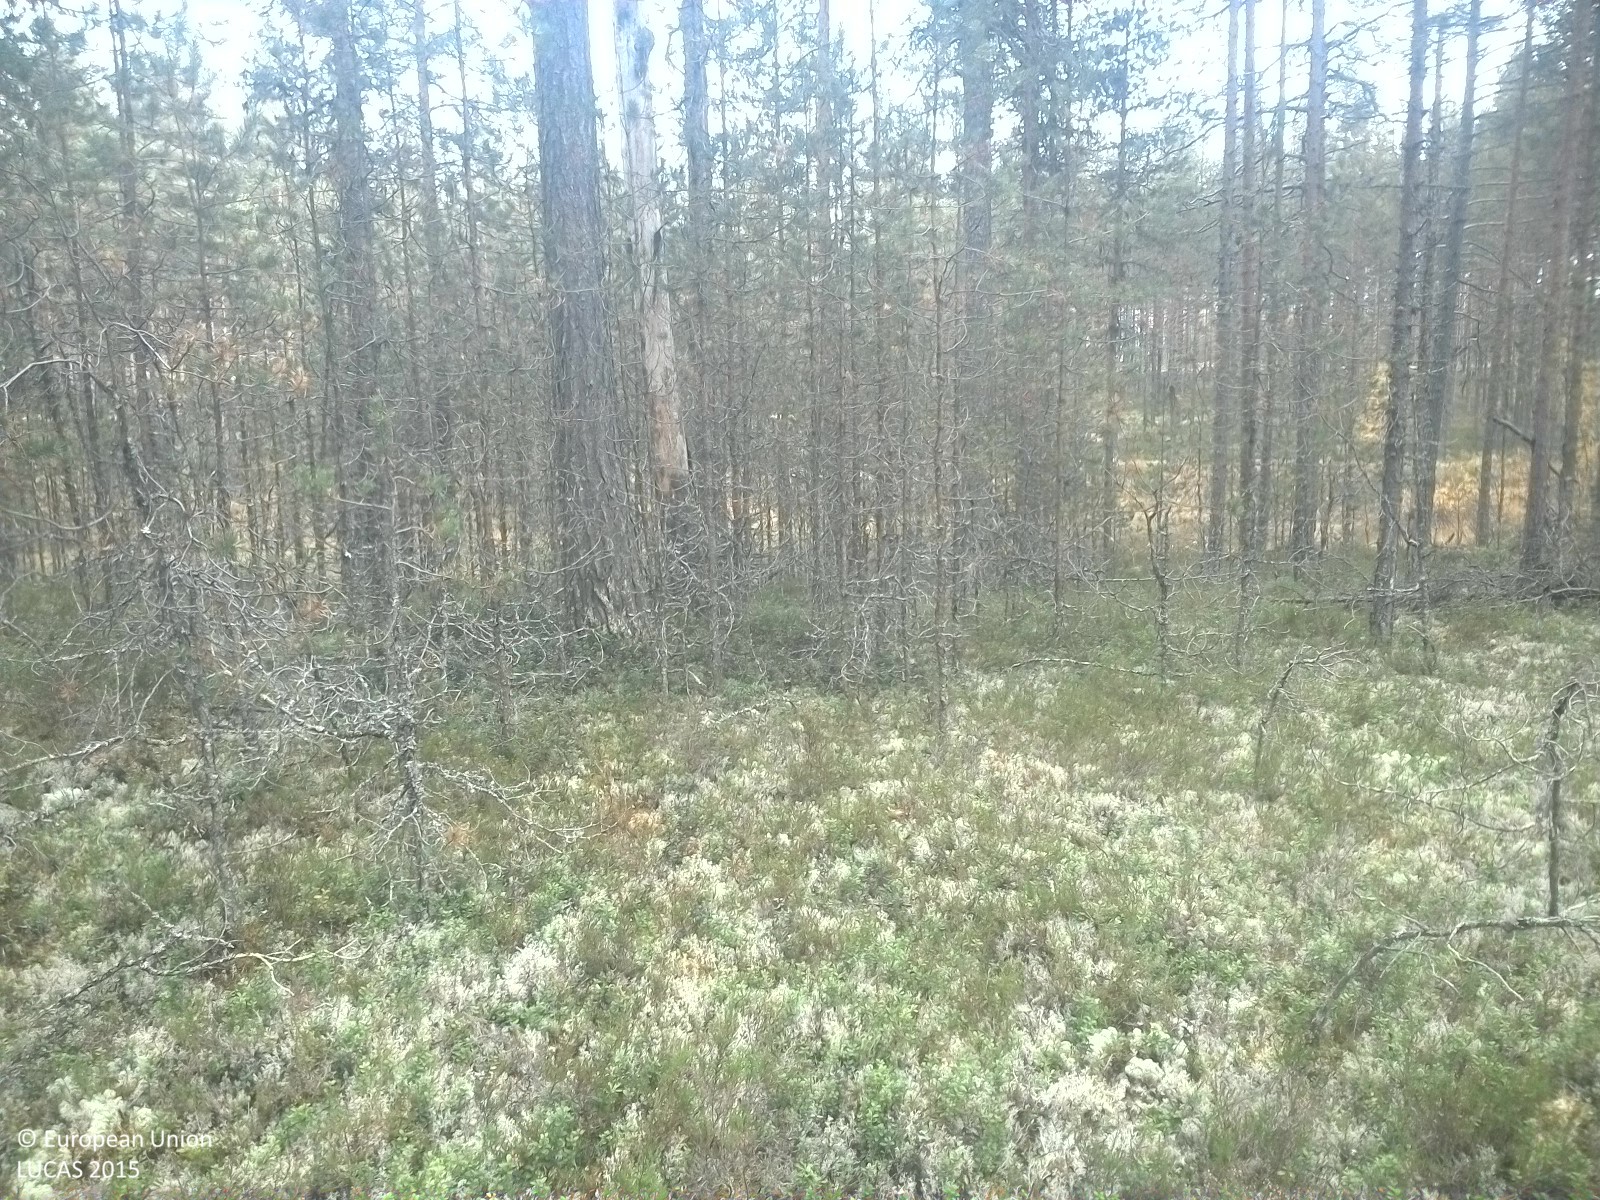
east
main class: Woodland
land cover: Pine dominated coniferous woodland
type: boreal forest
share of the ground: 50 - 75 %
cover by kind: coniferous forest trees 50 %, lichens and mosses 40 %, shrubs 10 %
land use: Forestry
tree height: > 5 m
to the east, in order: Pine dominated coniferous woodland; Peatbogs; Pine dominated coniferous woodland; Paved roads, cycling and walking lanes; Pine dominated coniferous woodland
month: September
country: SE
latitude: 62.2033
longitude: 15.5361
